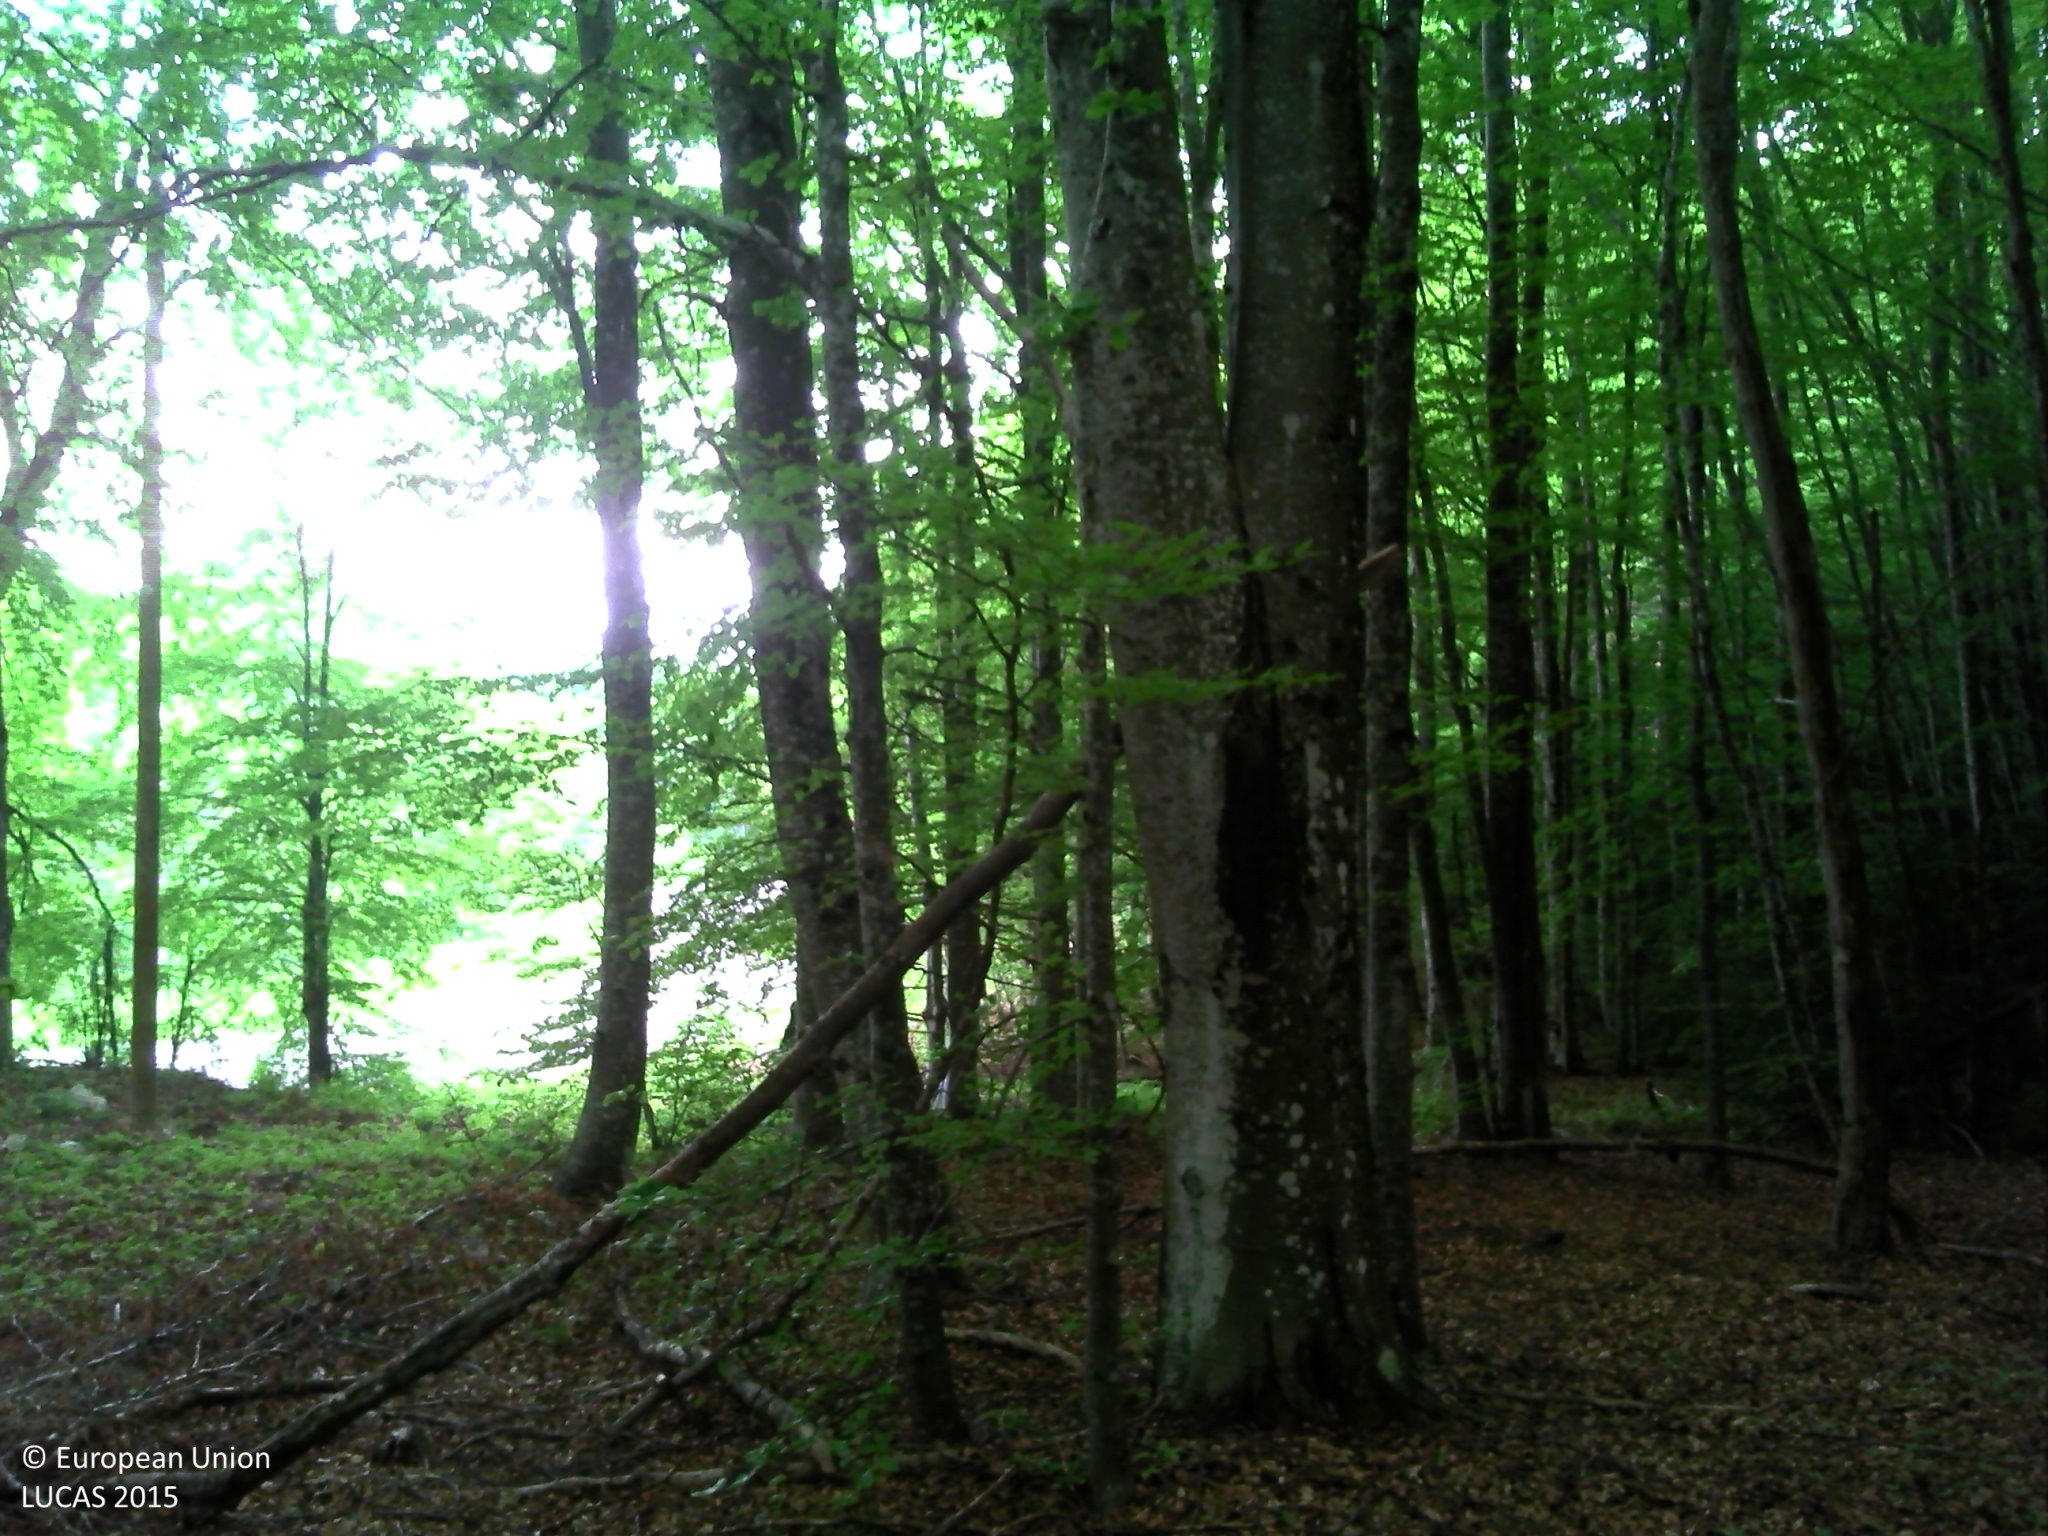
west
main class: Woodland
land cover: Broadleaved woodland
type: beech forest
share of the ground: > 75 %
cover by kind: broadleaved forest trees 95 %, lichens and mosses 5 %
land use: Semi-natural and natural areas not in use
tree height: > 5 m
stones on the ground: < 10 %
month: May
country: FR
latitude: 44.8877
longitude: 5.1568
